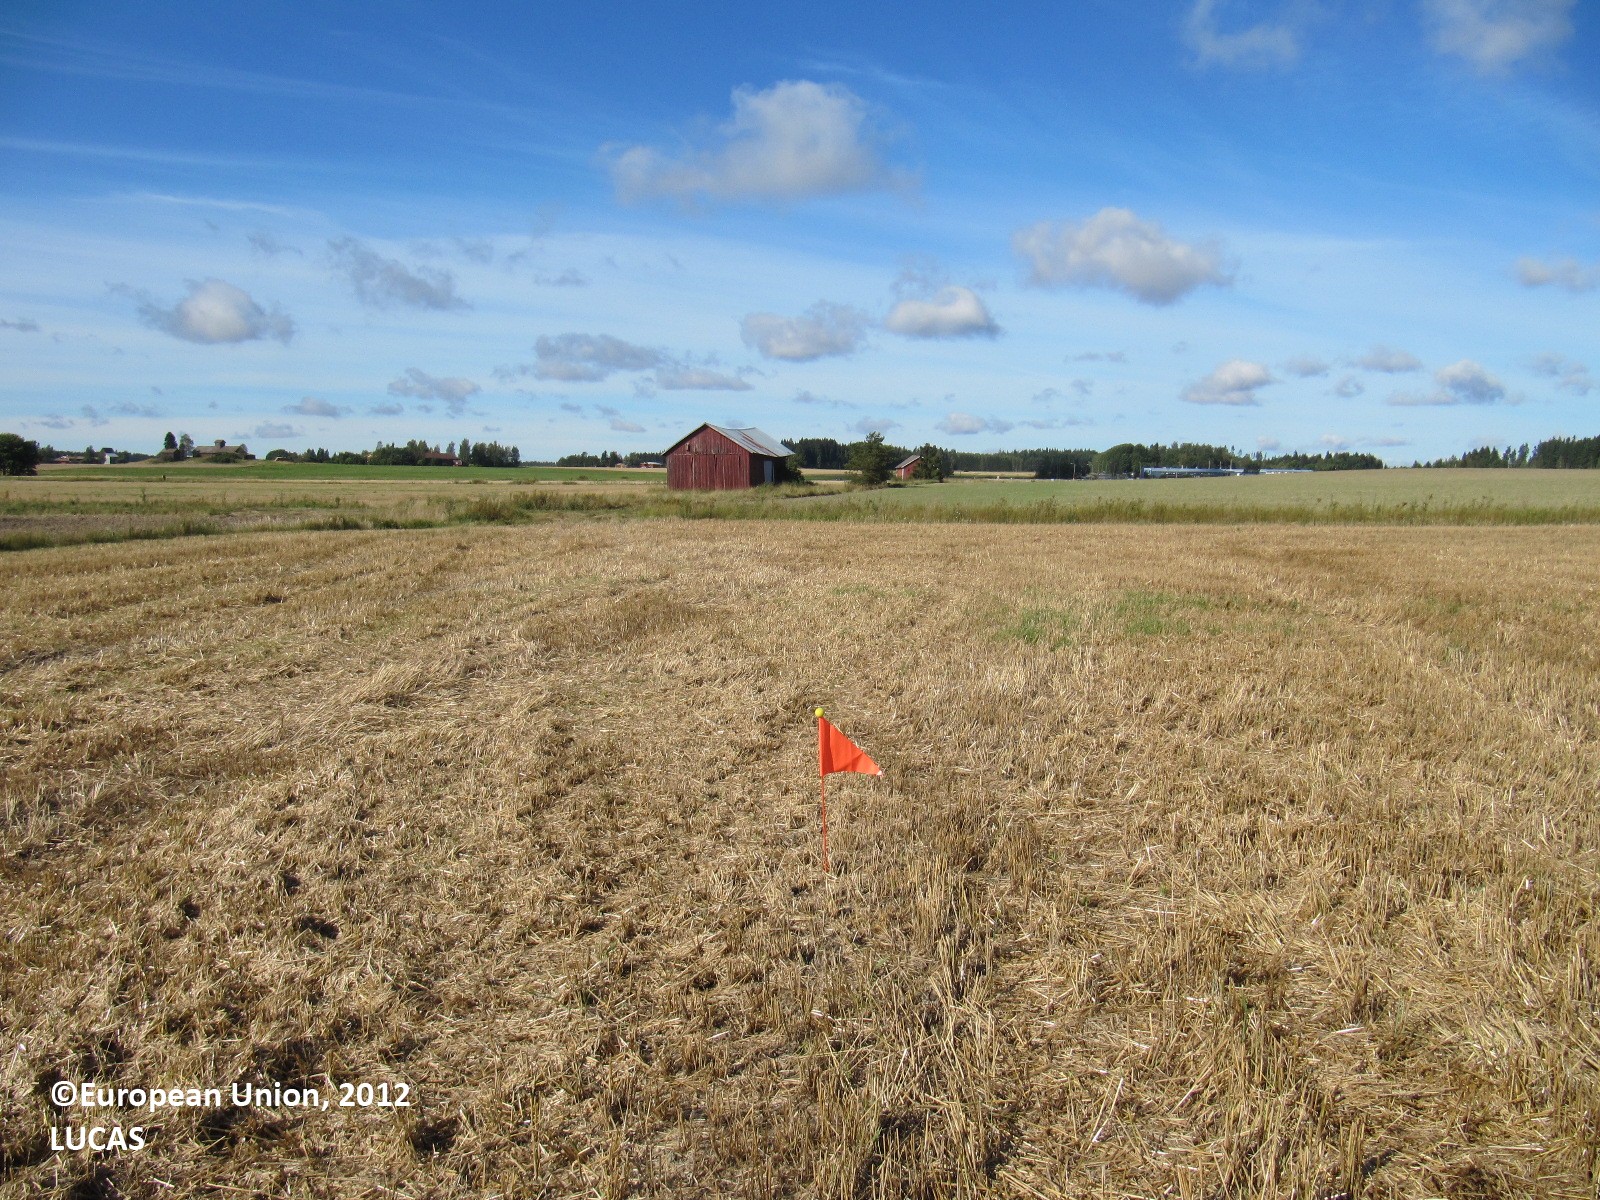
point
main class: Cropland
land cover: Barley
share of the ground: 50 - 75 %
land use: Agriculture (excluding fallow land and kitchen gardens)
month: September
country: FI
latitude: 60.7925
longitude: 23.2898
